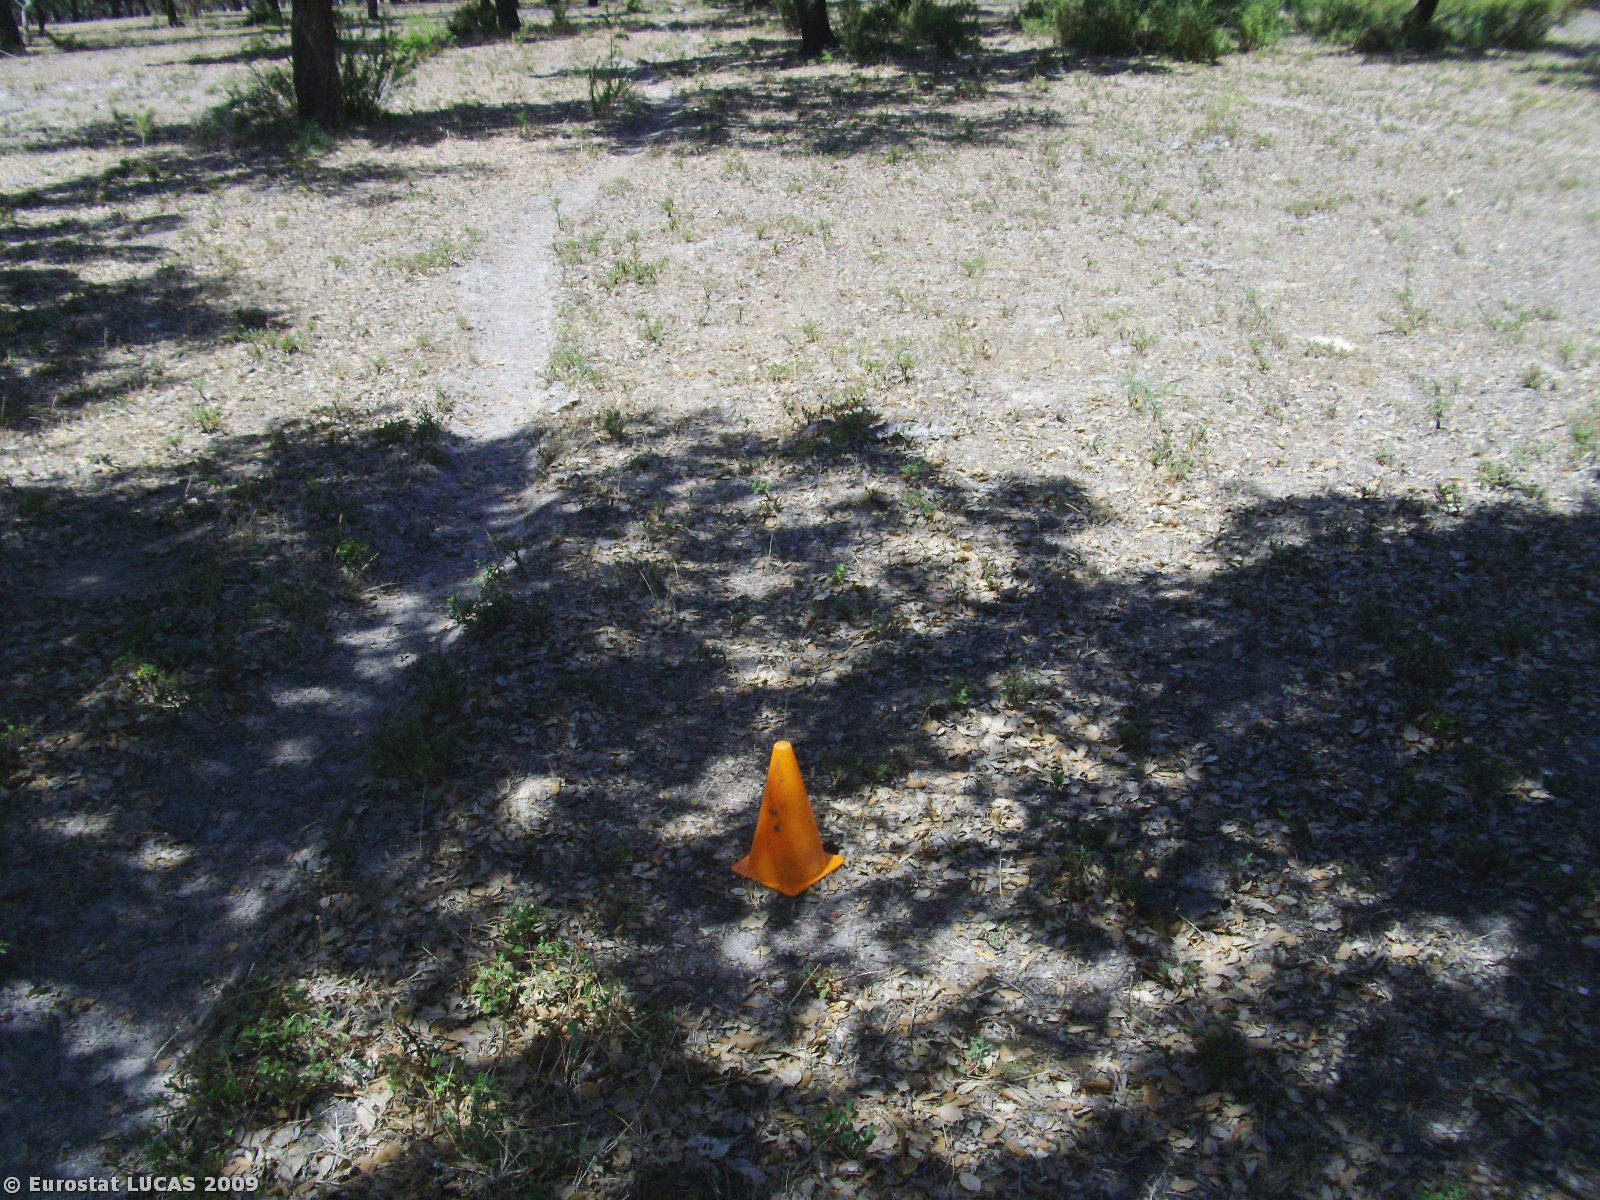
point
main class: Woodland
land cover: Broadleaved woodland
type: broadleaved evergreen forest
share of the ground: 25 - 50 %
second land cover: Spontaneously vegetated surfaces
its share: 50 - 75 %
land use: Forestry
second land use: Fallow land
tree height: > 5 m
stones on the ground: 10 - 25 %
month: August
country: PT
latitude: 38.6960
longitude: -8.8655
